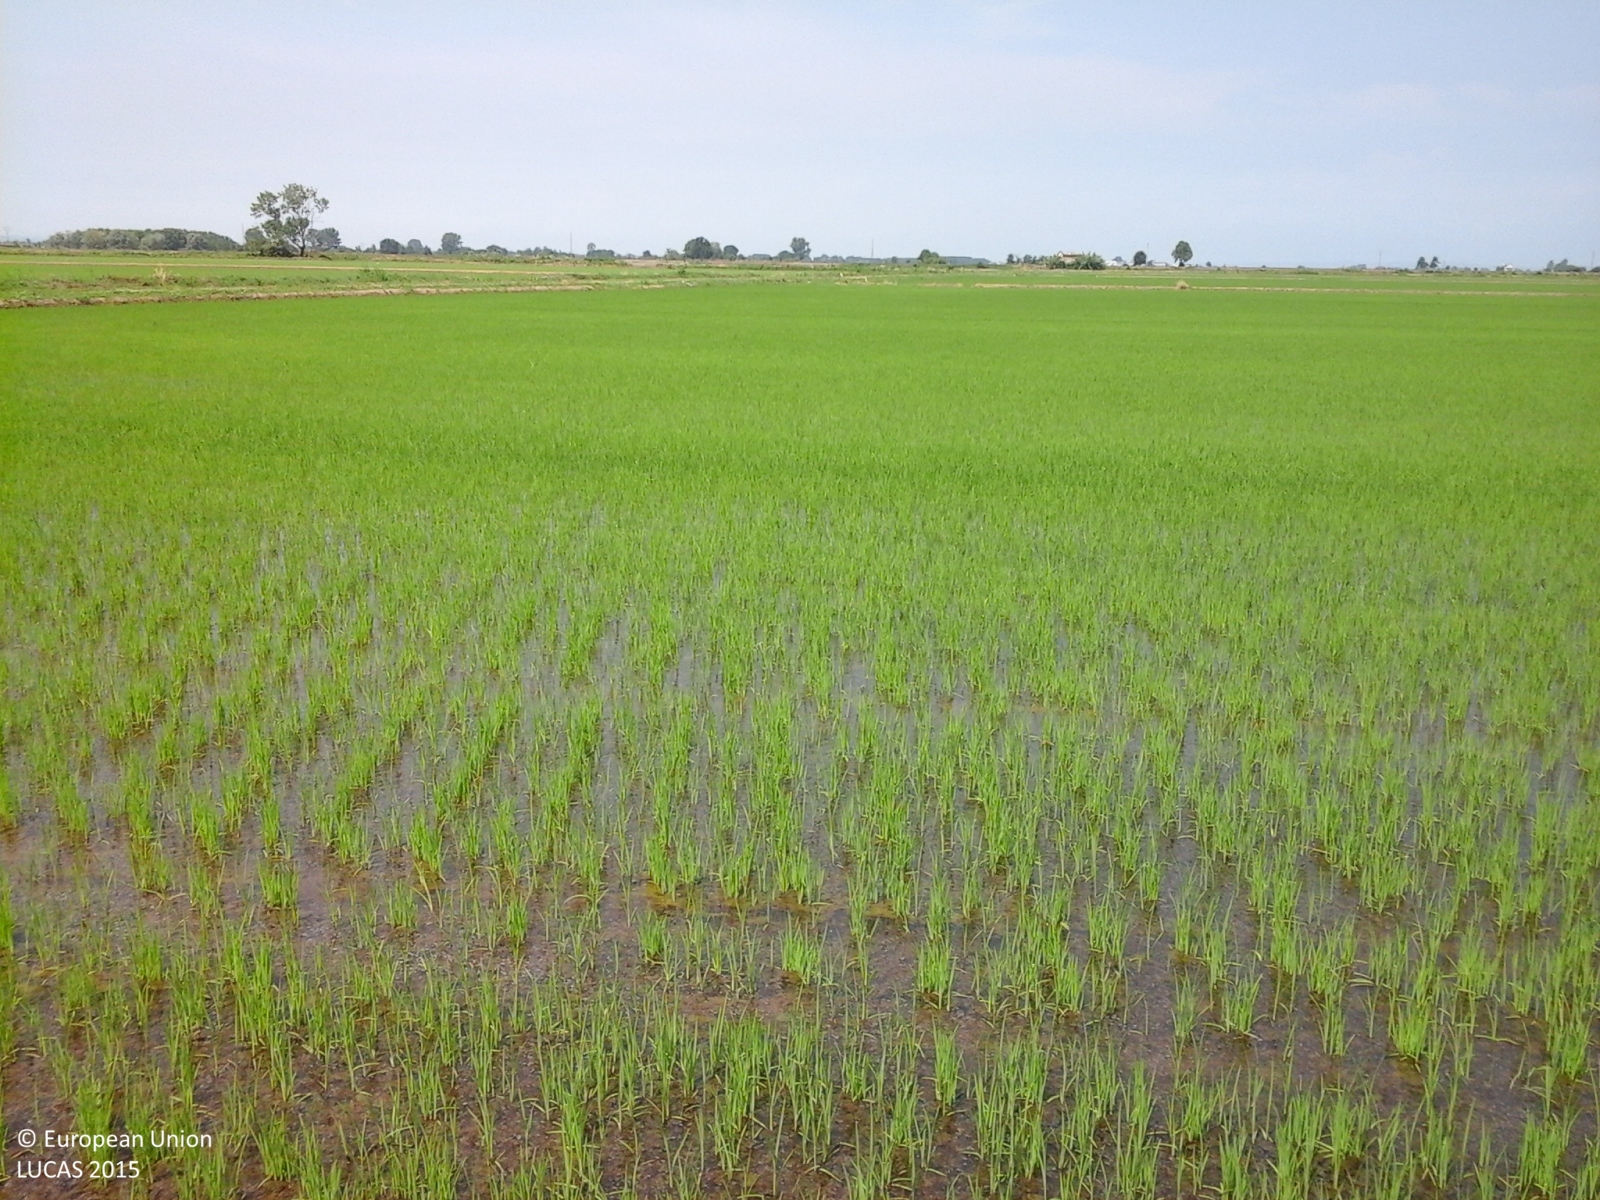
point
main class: Cropland
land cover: Rice
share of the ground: 25 - 50 %
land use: Agriculture (excluding fallow land and kitchen gardens)
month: June
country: IT
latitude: 45.2224
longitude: 8.4363
